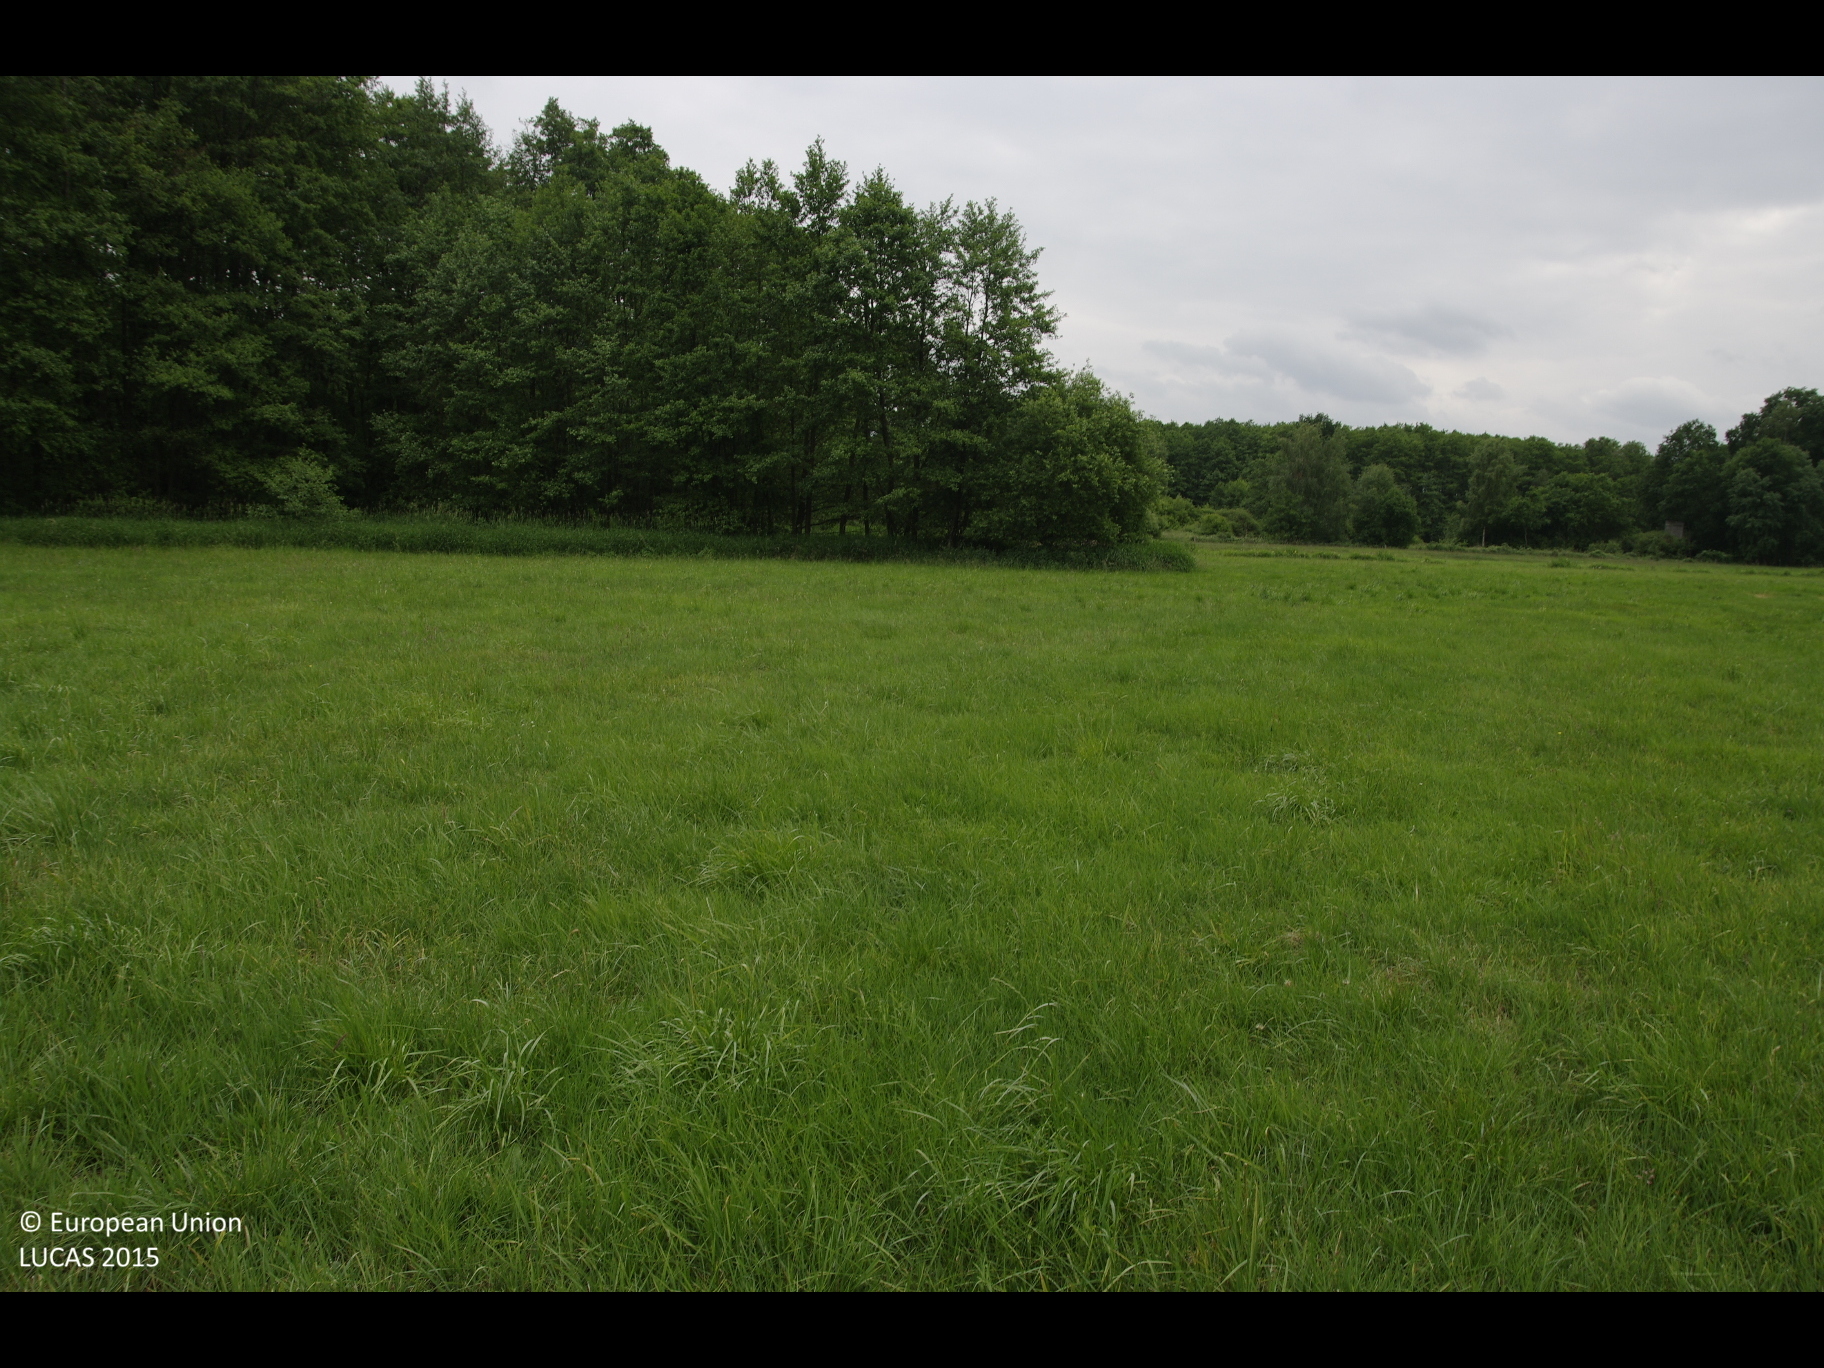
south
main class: Grassland
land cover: Grassland without tree/shrub cover
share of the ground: > 75 %
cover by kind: herbaceous plants 100 %
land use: Agriculture (excluding fallow land and kitchen gardens)
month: June
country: DE
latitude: 53.2038
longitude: 10.3142
